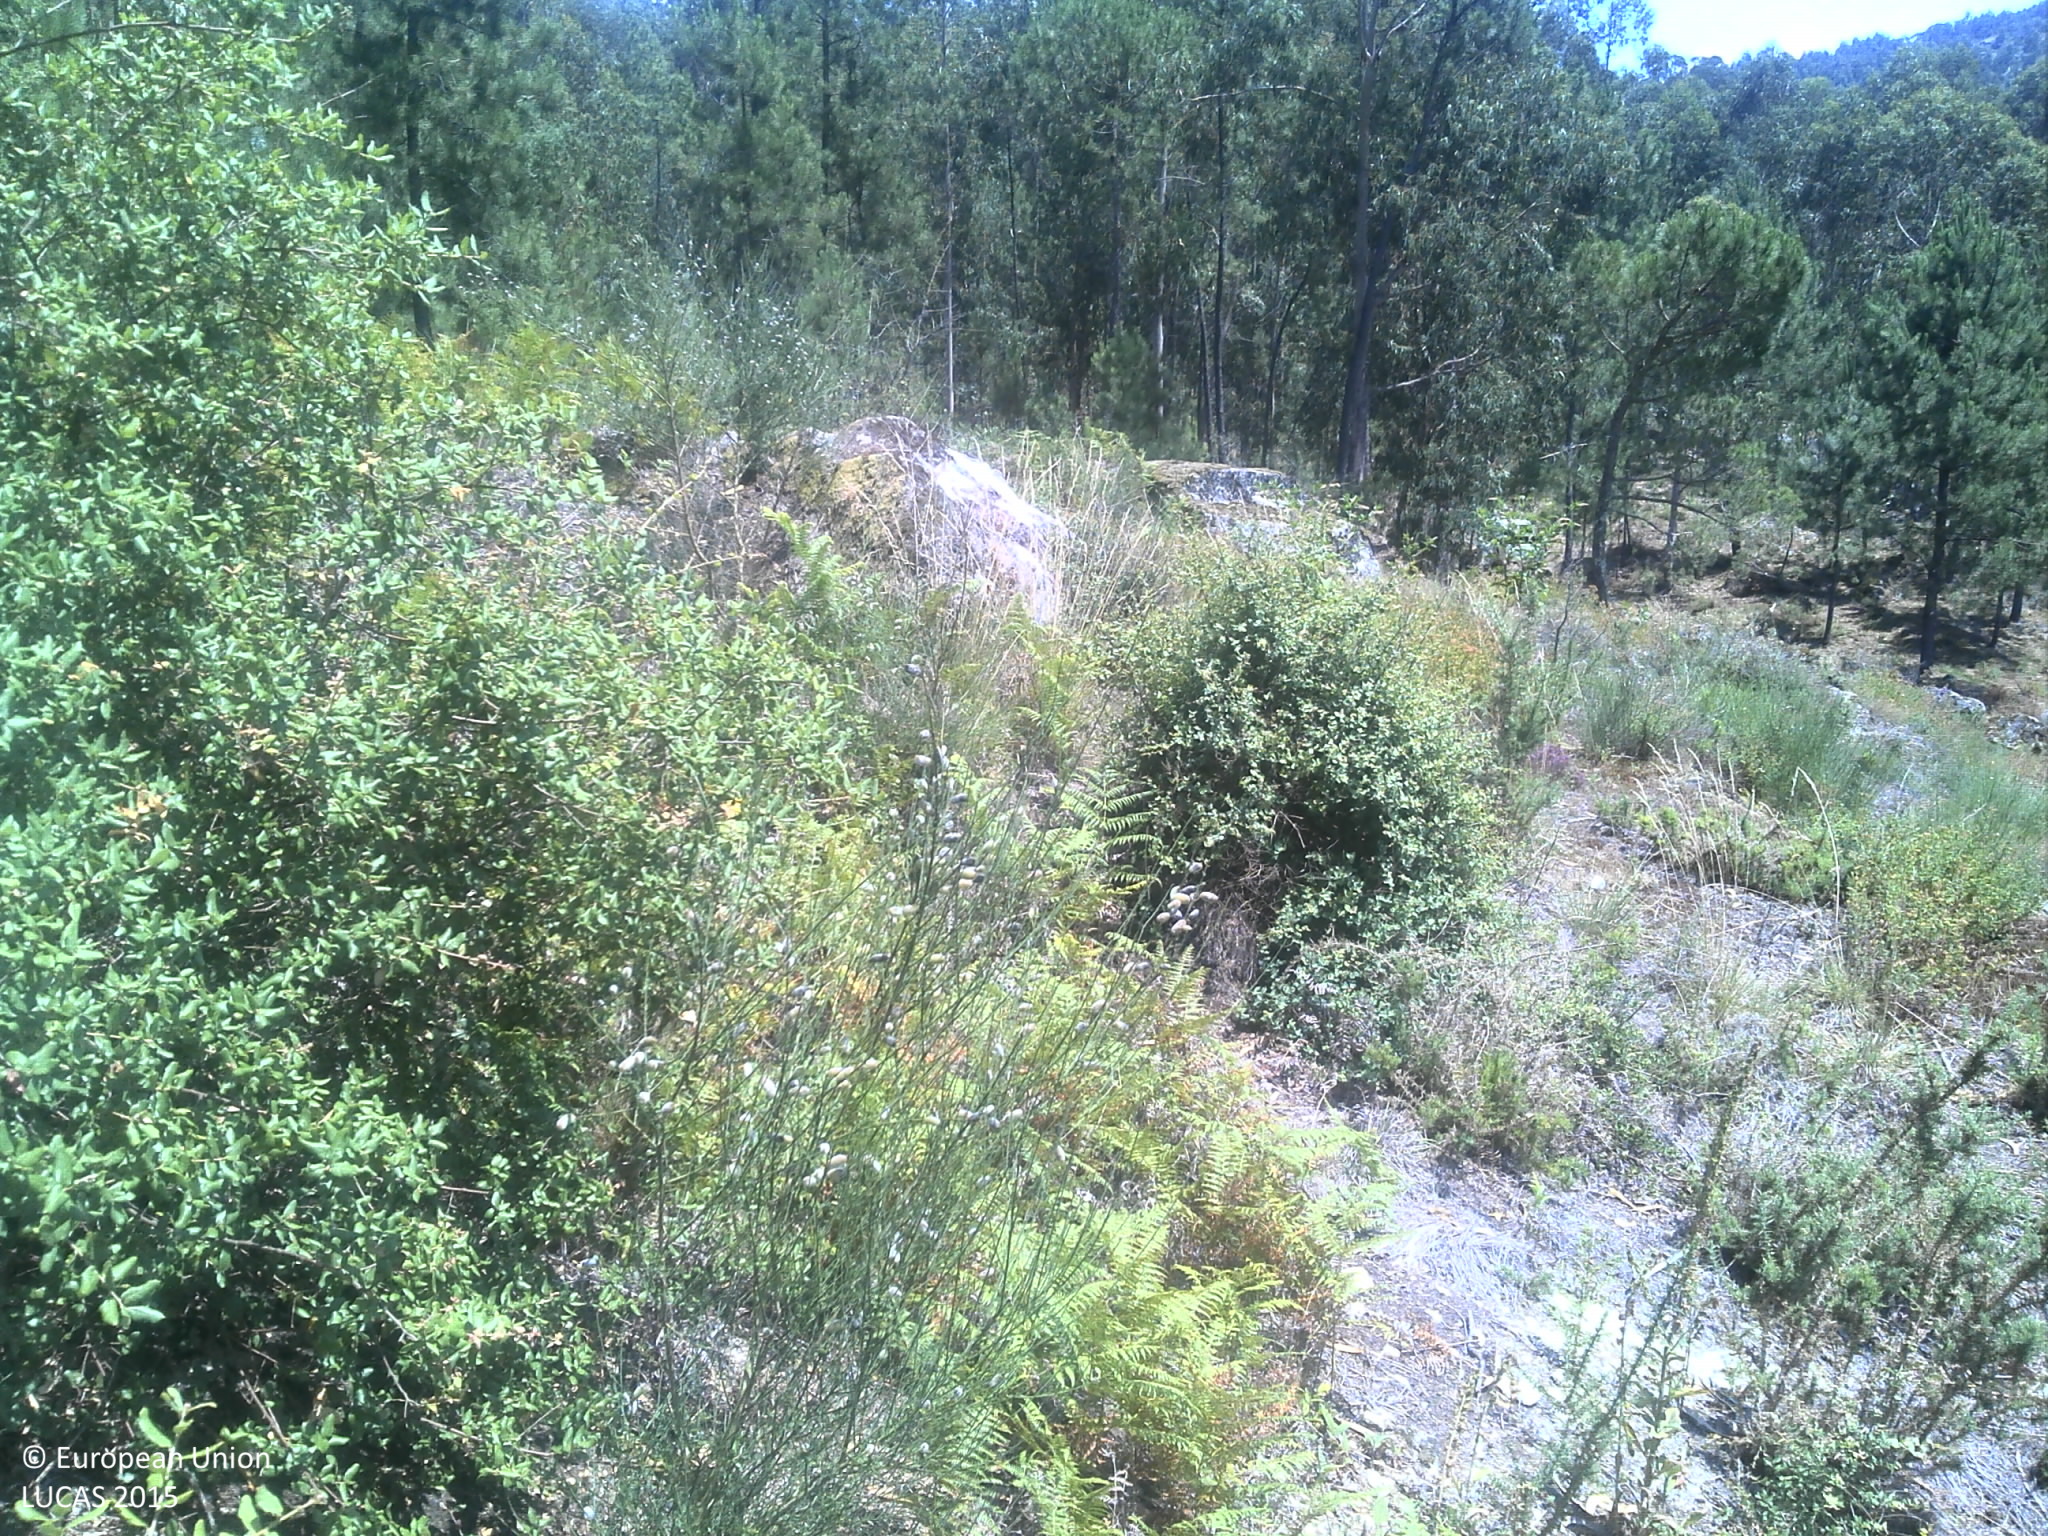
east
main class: Shrubland
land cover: Shrubland with sparse tree cover
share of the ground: 50 - 75 %
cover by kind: shrubs 60 %, unconsolidated bare surface 25 %, consolidated bare surface 10 %, broadleaved forest trees 5 %
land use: Forestry
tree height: < 5 m
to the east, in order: Shrubland with sparse tree cover; Rock outcrops; Shrubland without tree cover; Rock outcrops; Pine dominated mixed woodland; Broadleaved woodland; Tracks; Broadleaved woodland
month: June
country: PT
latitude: 41.5840
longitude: -8.5711
